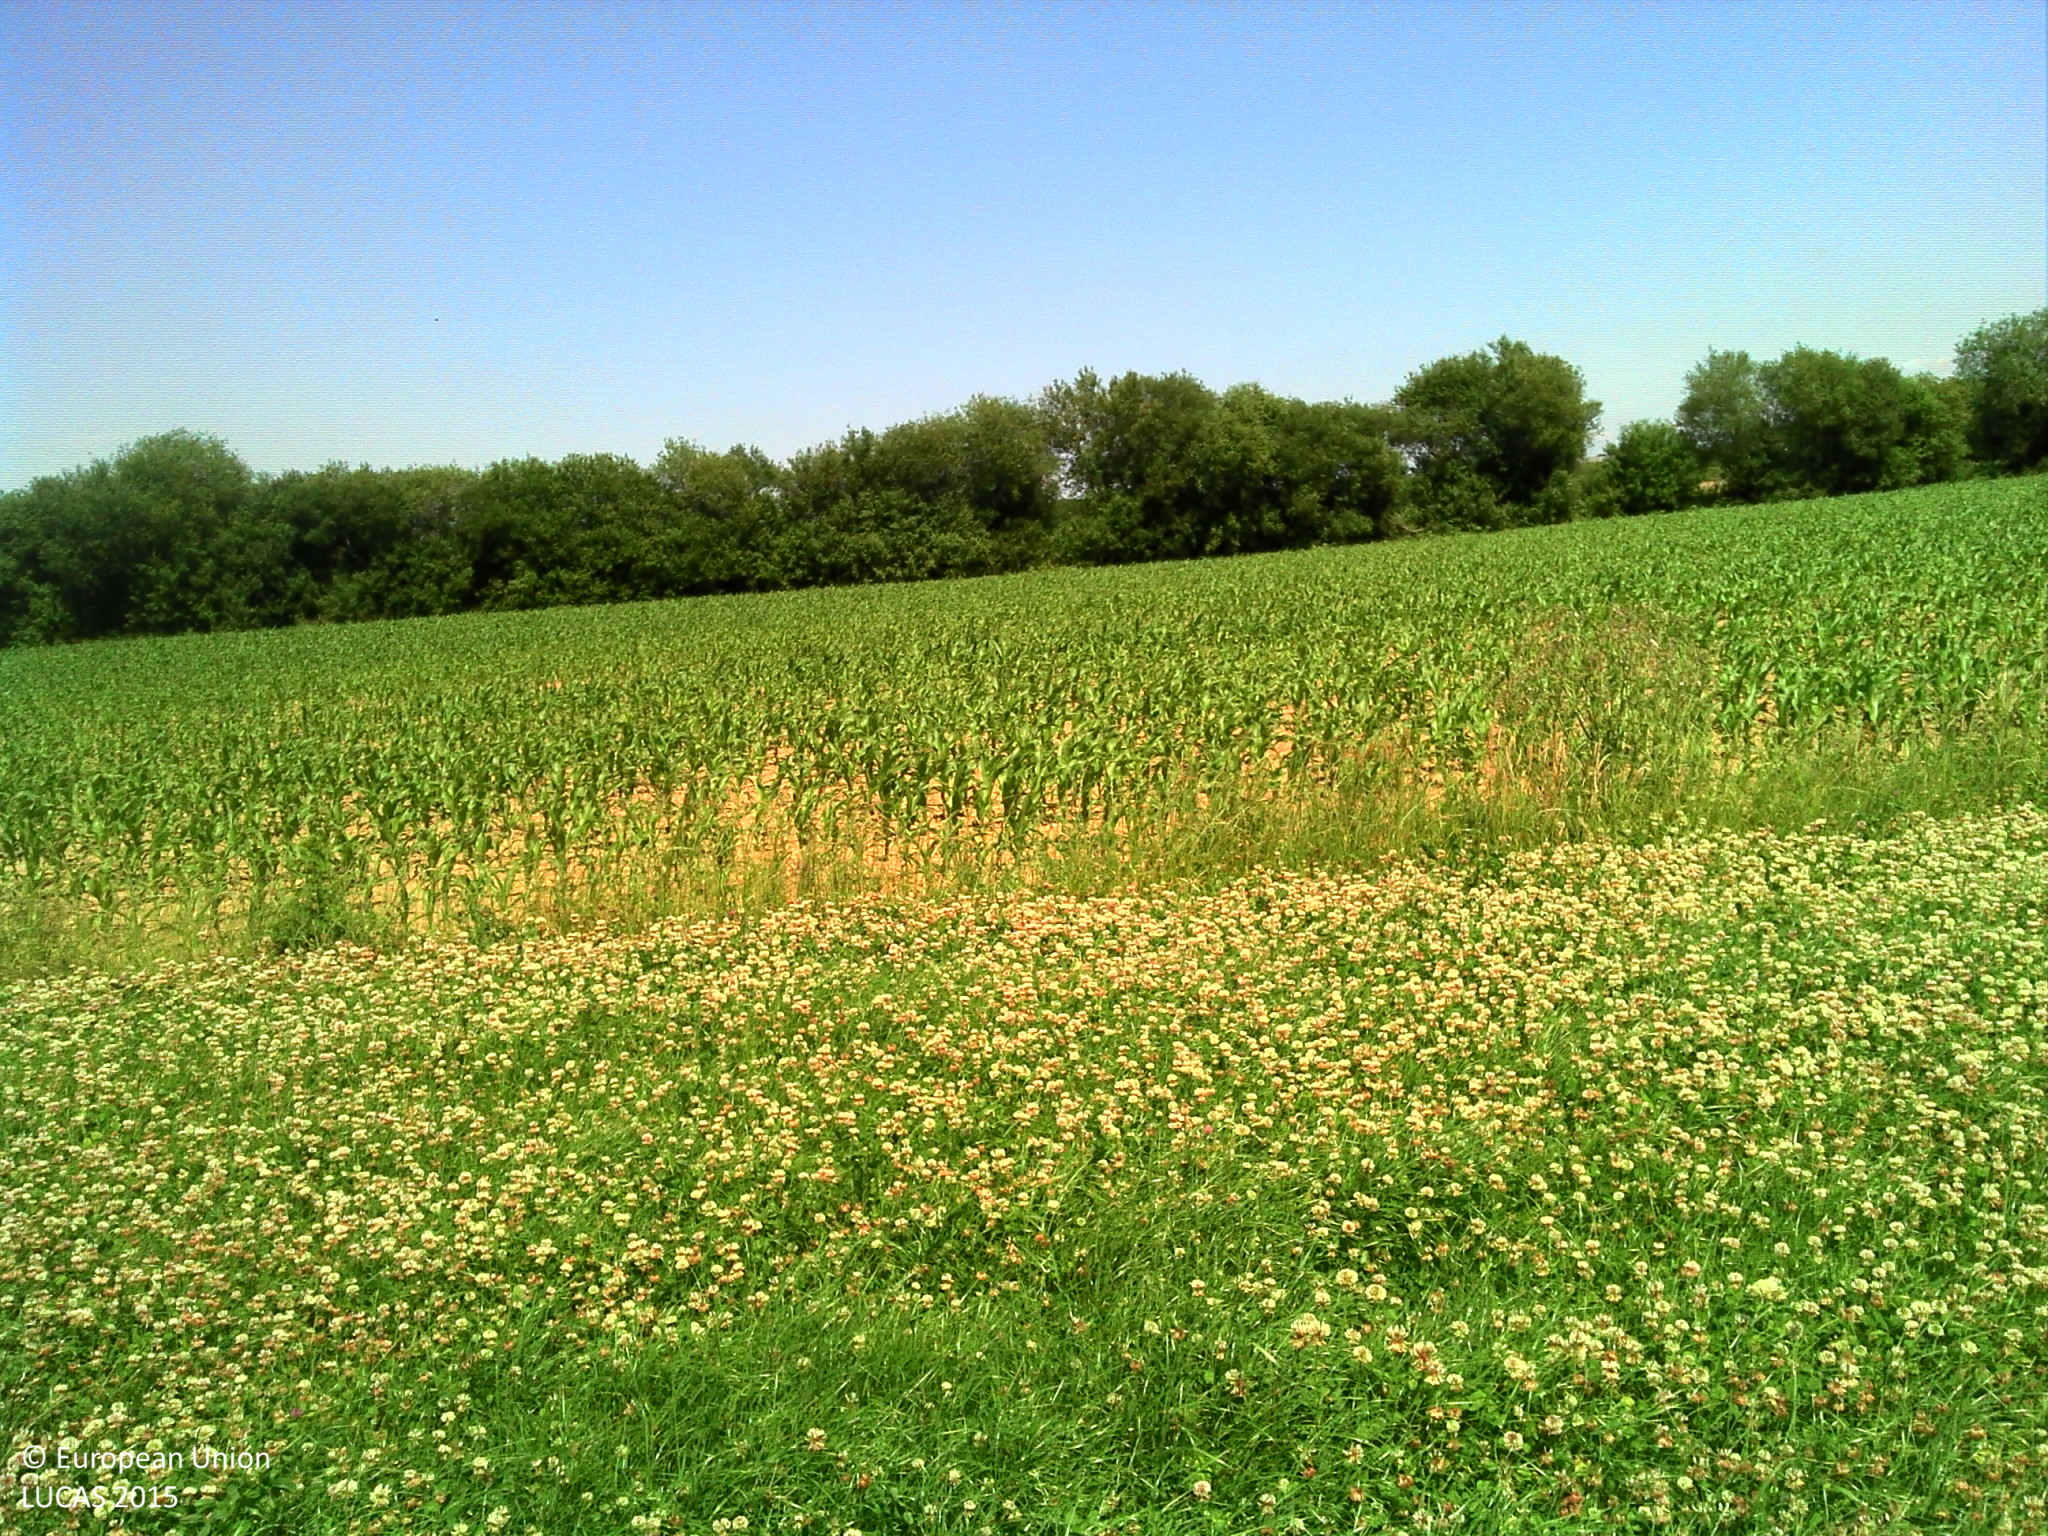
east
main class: Cropland
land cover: Clovers
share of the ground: > 75 %
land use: Agriculture (excluding fallow land and kitchen gardens)
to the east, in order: Clovers; Maize; Abandoned hedges; Grassland without tree/shrub cover
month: June
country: FR
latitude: 48.0136
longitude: -1.7249
